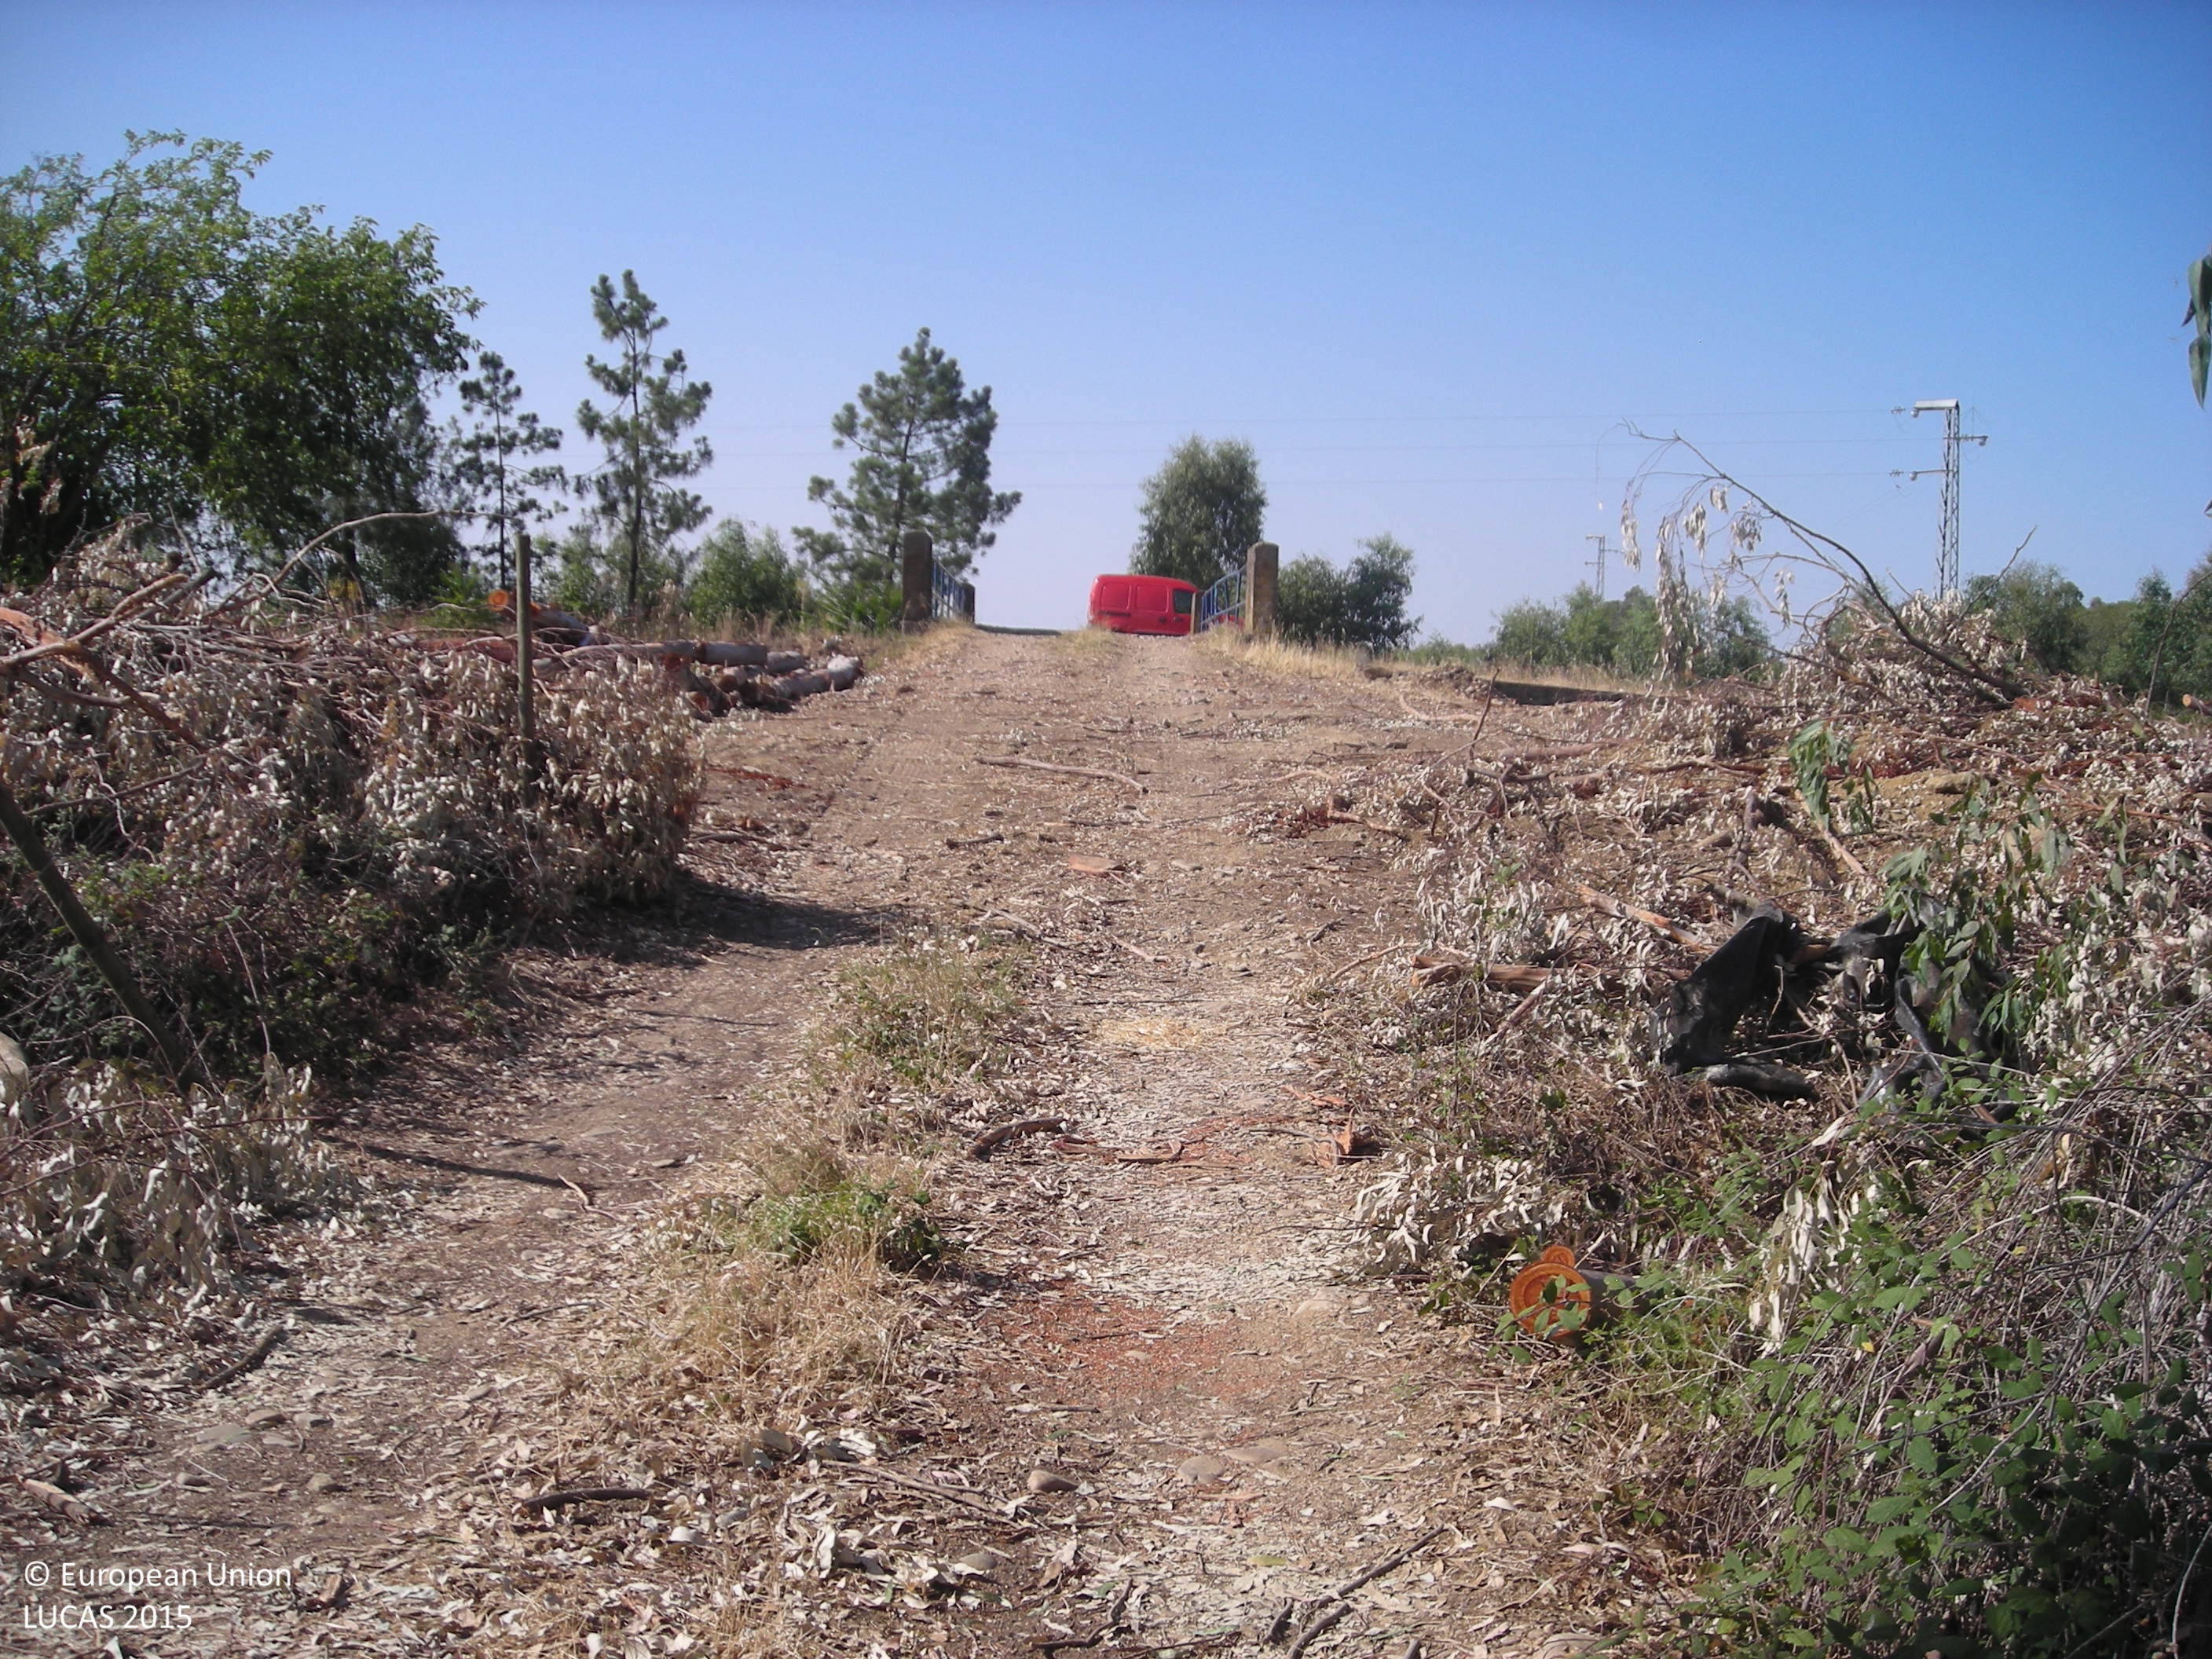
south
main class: Woodland
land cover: Broadleaved woodland
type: broadleaved evergreen forest
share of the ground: 50 - 75 %
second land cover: Grassland without tree/shrub cover
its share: 50 - 75 %
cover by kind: herbaceous plants 60 %, broadleaved forest trees 40 %
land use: Forestry
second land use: Agriculture (excluding fallow land and kitchen gardens)
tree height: > 5 m
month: July
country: ES
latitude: 39.1550
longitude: -5.7304
